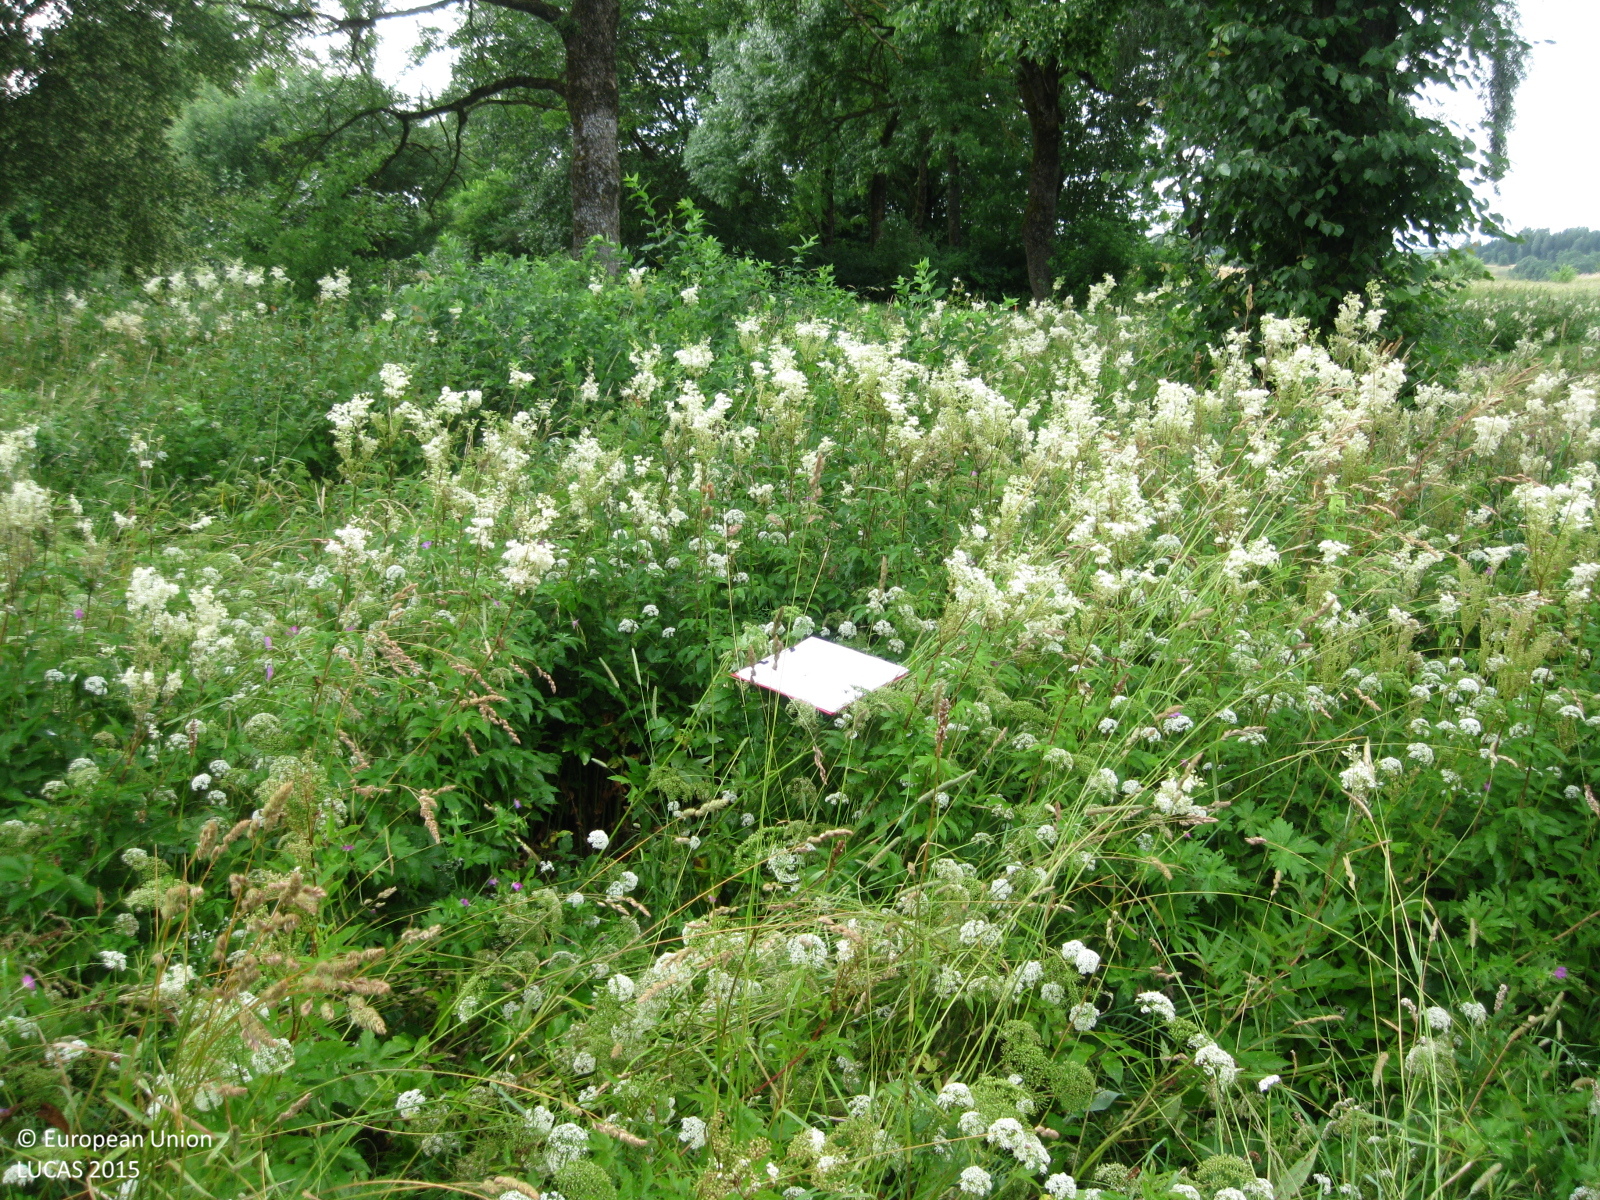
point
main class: Grassland
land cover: Spontaneously vegetated surfaces
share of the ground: > 75 %
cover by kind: herbaceous plants 100 %
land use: Fallow land
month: July
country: LT
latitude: 55.7817
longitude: 24.7909
